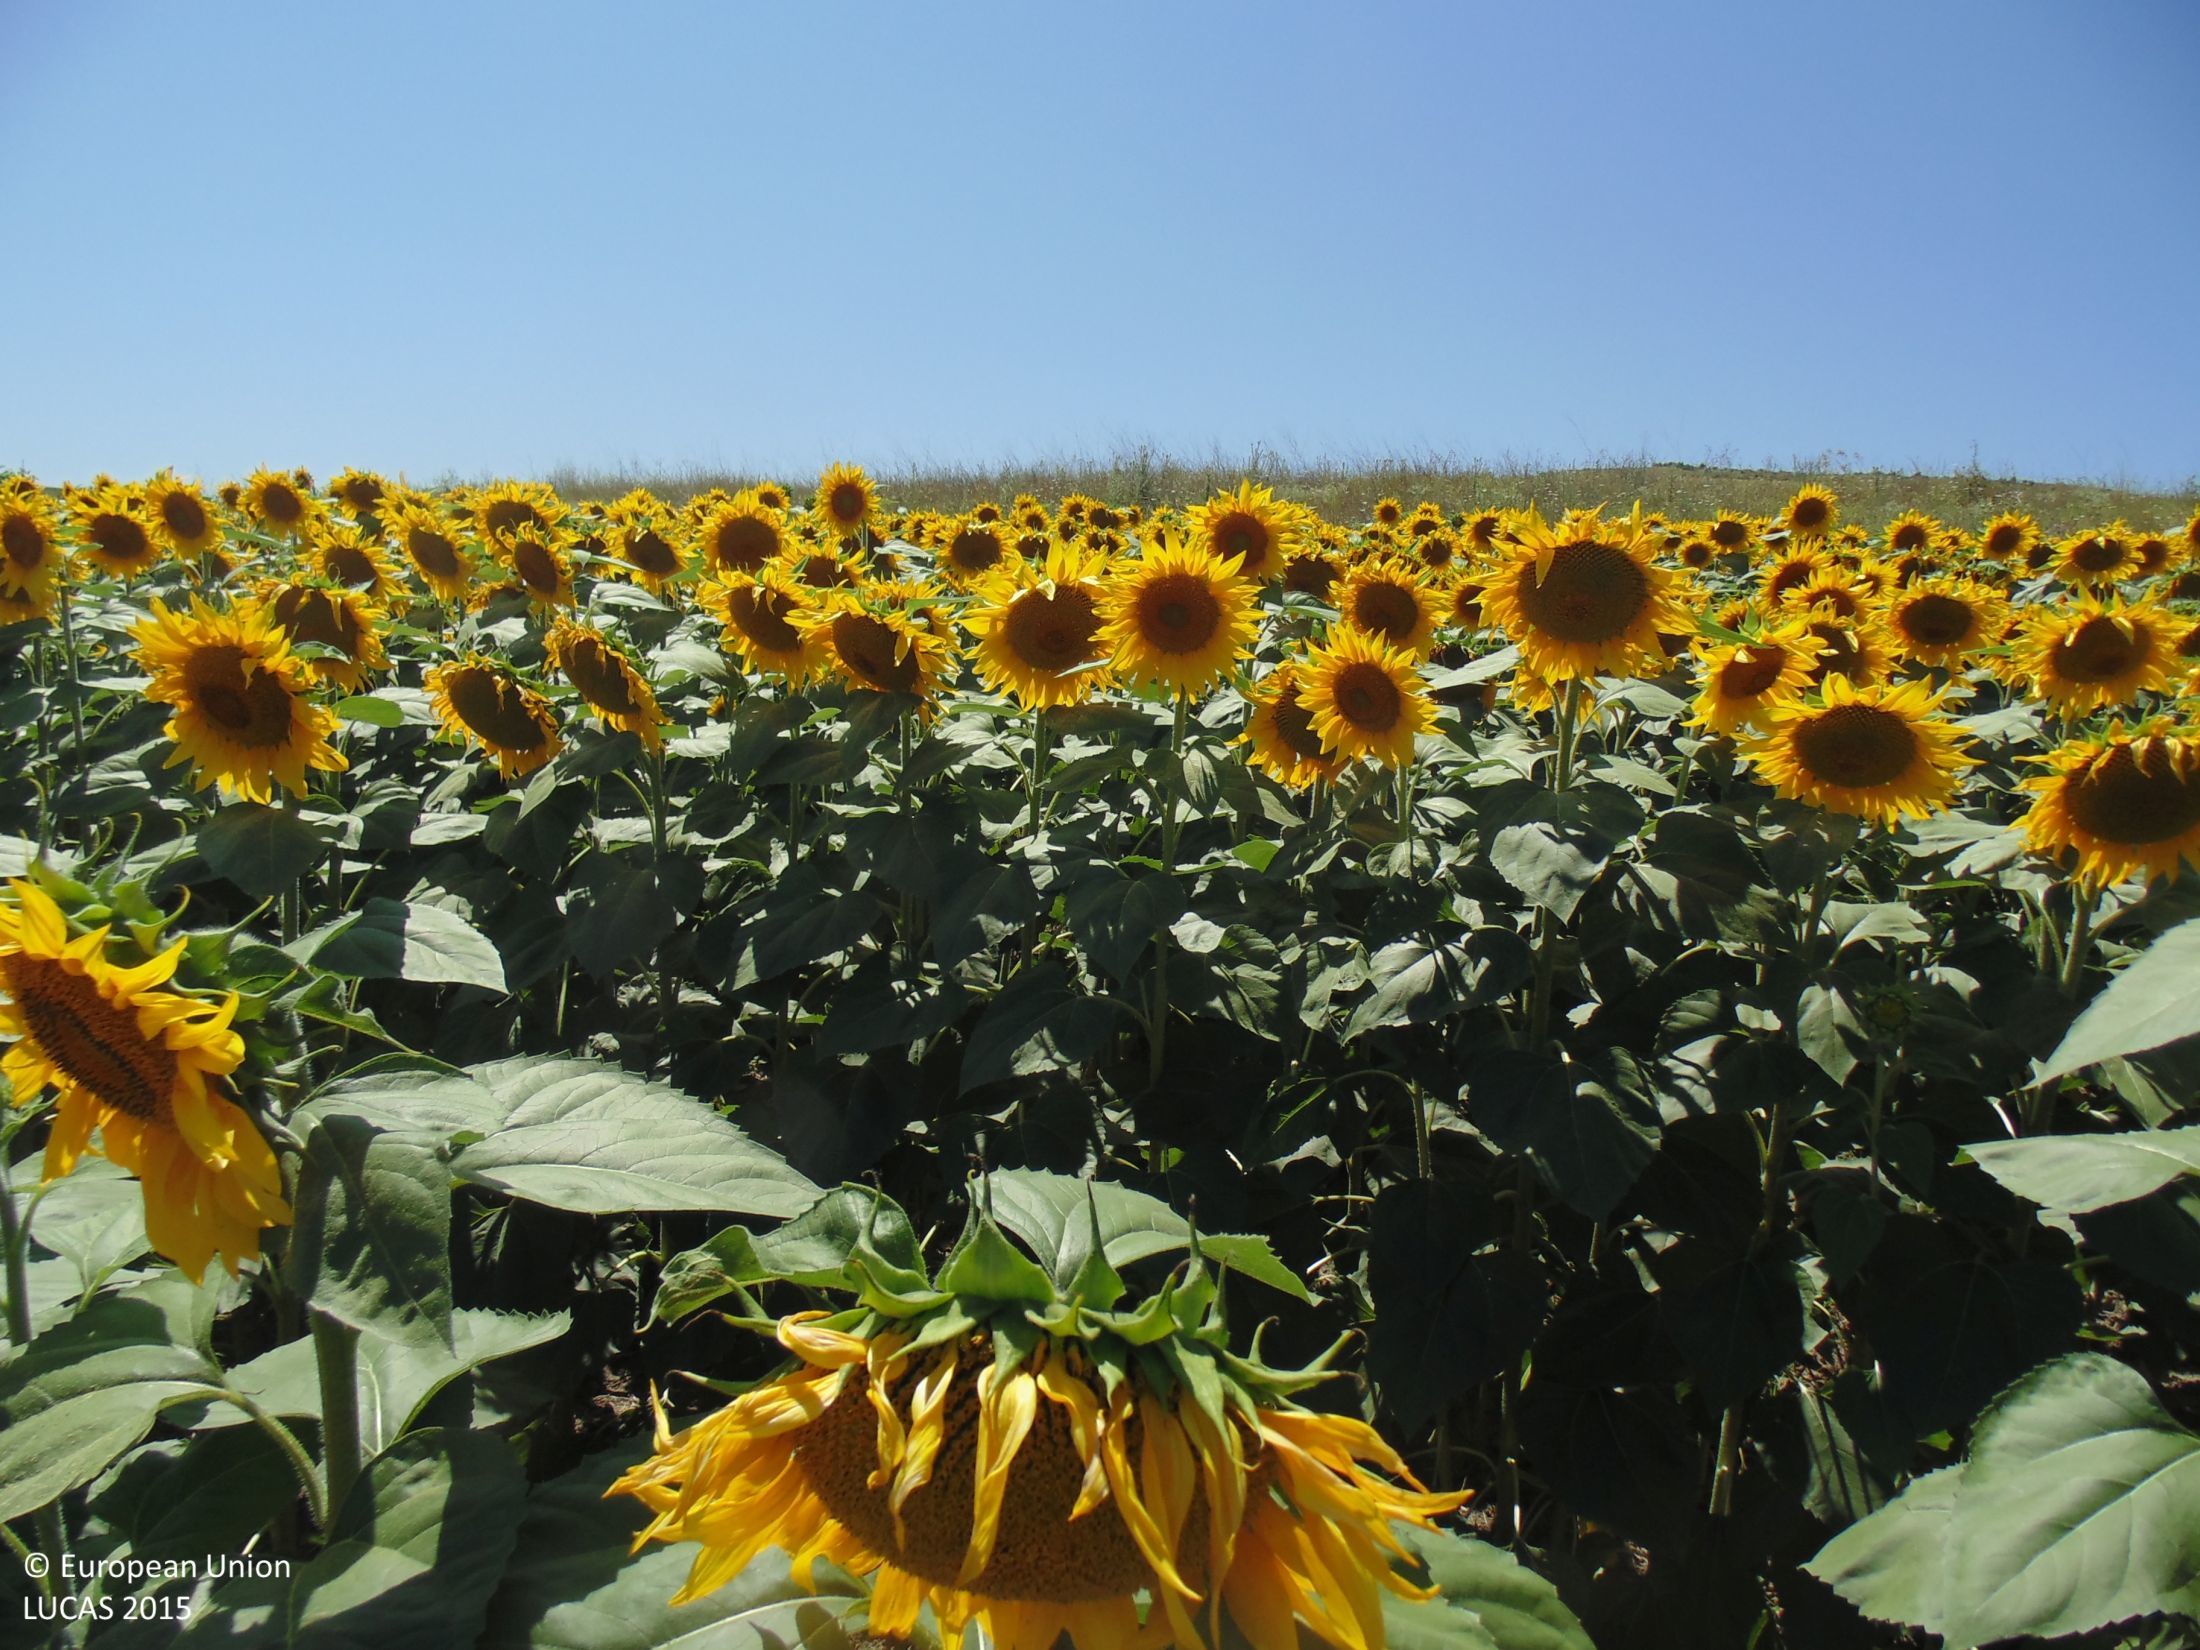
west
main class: Cropland
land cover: Sunflower
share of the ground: > 75 %
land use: Agriculture (excluding fallow land and kitchen gardens)
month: July
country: BG
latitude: 43.3647
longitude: 28.0252
